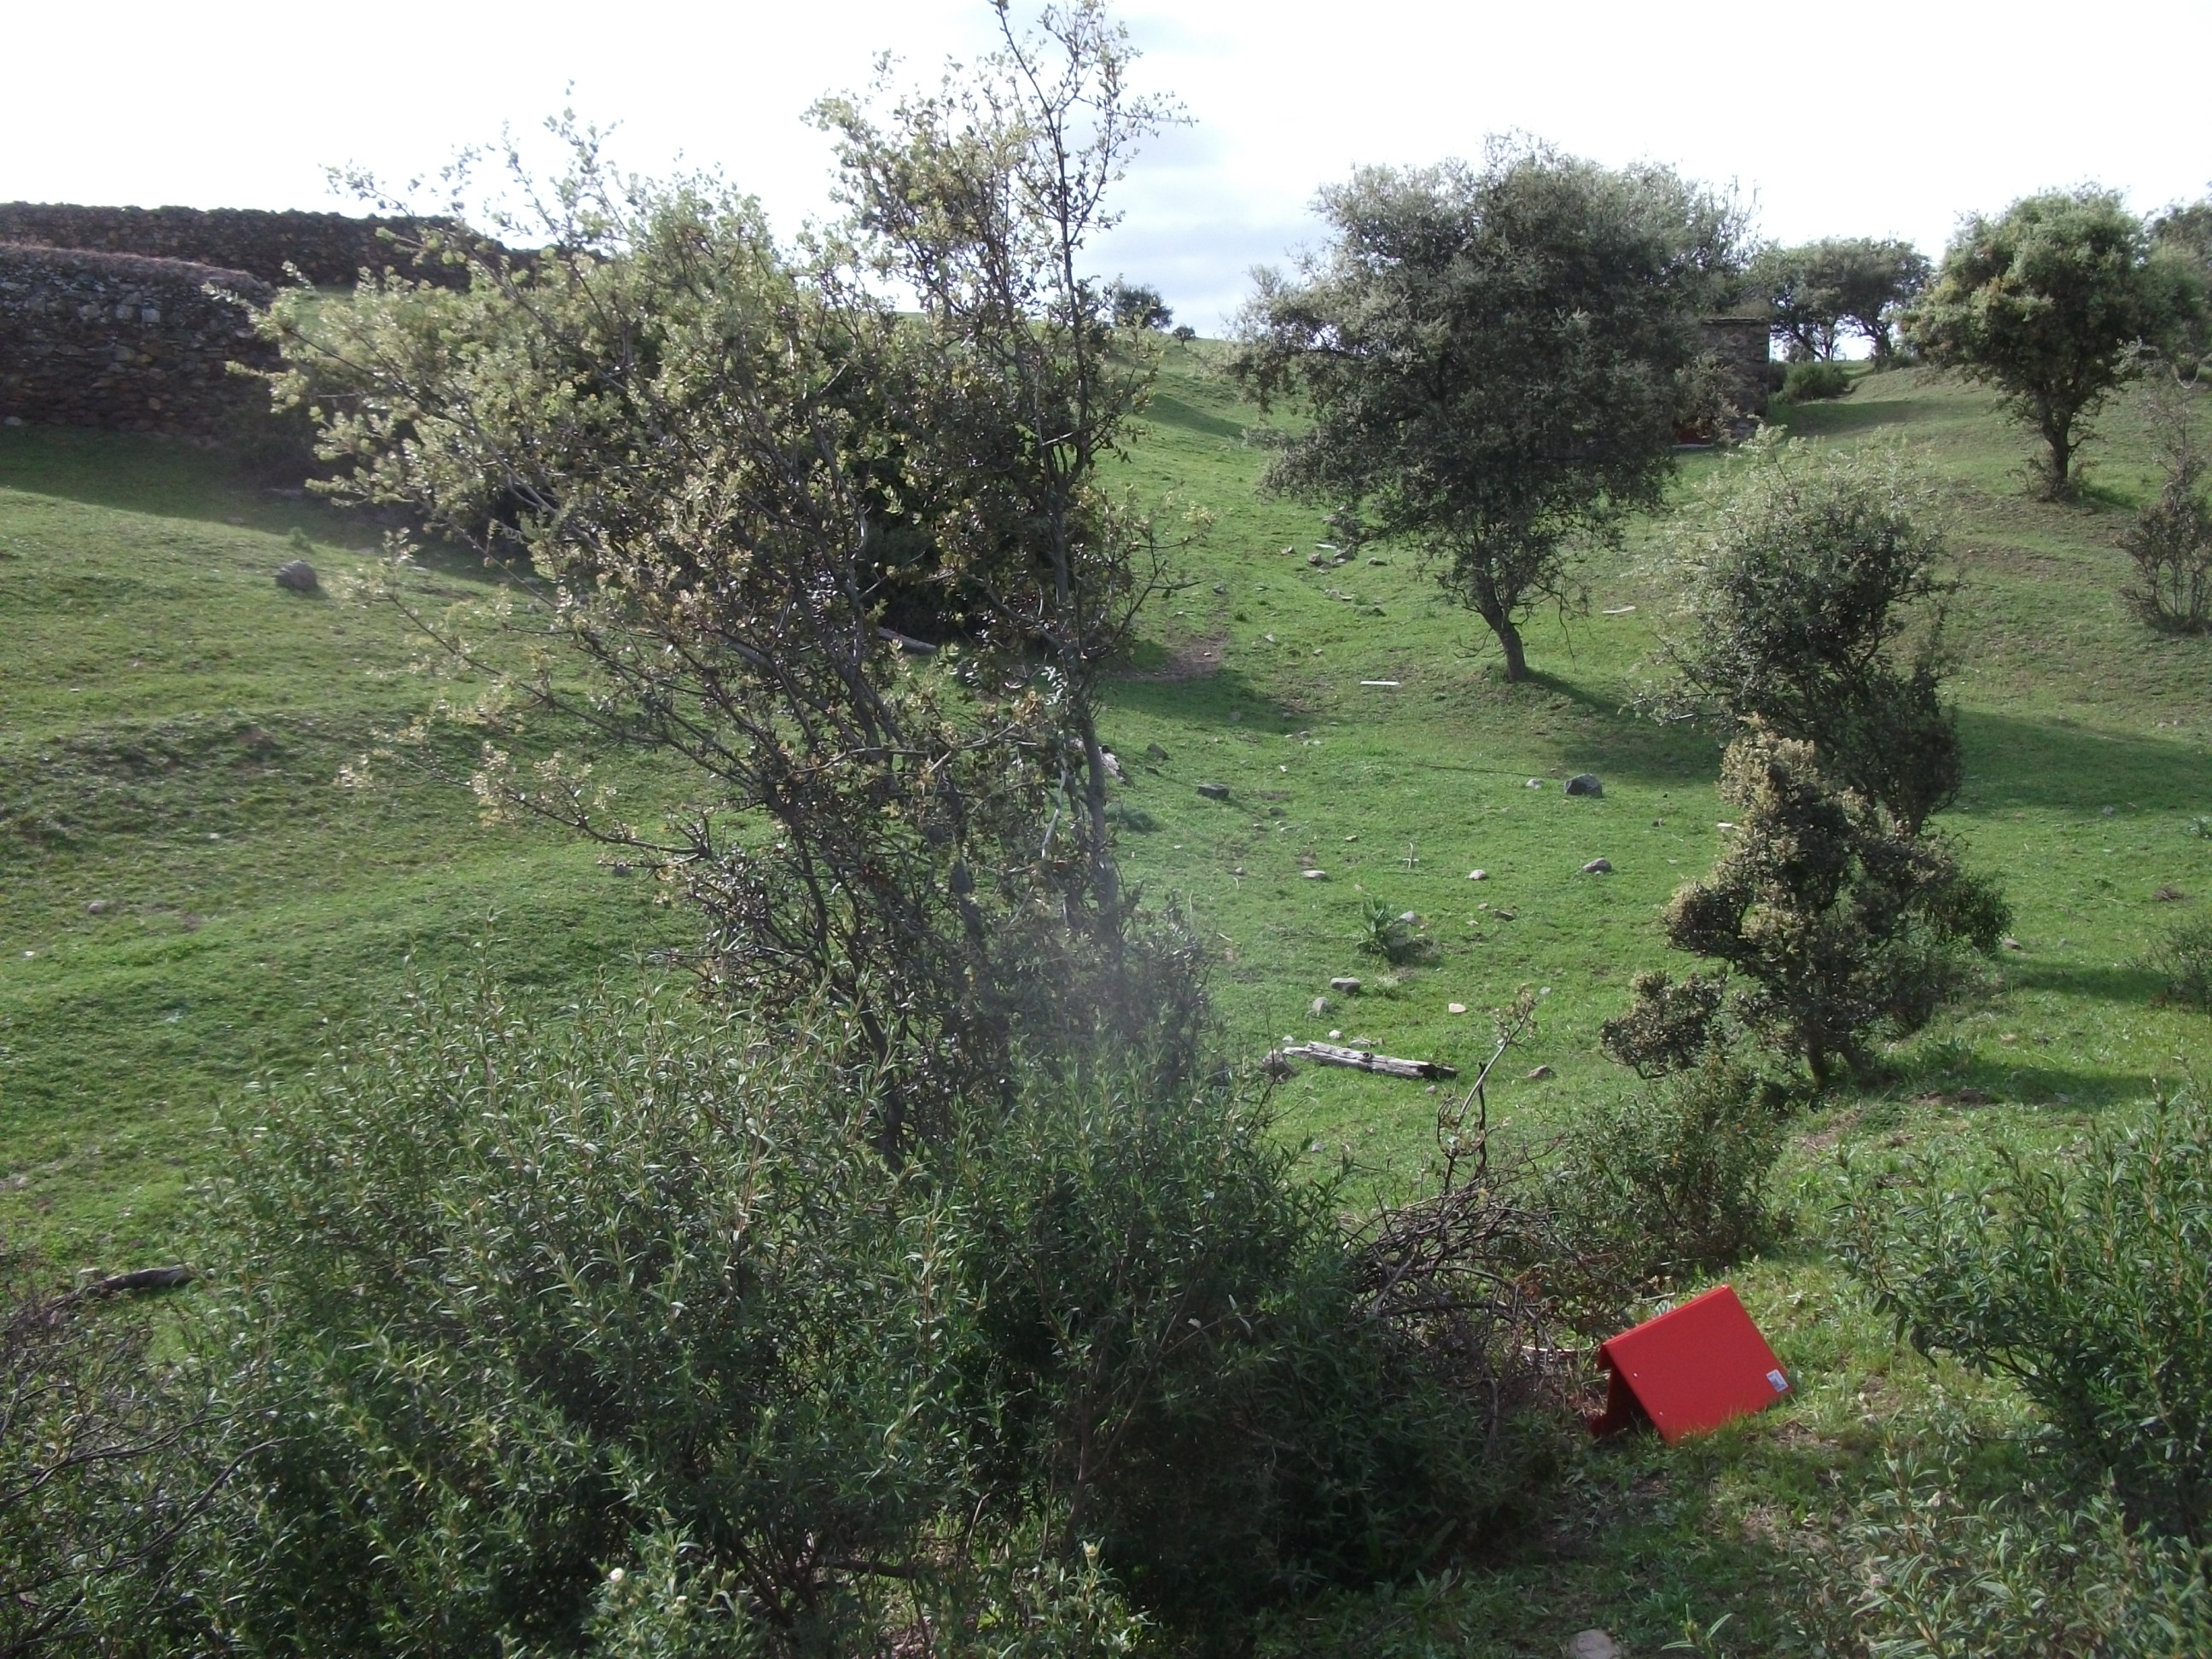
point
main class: Woodland
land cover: Broadleaved woodland
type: broadleaved evergreen forest
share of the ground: 25 - 50 %
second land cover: Shrubland without tree cover
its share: 25 - 50 %
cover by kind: shrubs 40 %, broadleaved forest trees 30 %, herbaceous plants 30 %
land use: Forestry
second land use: Agriculture (excluding fallow land and kitchen gardens)
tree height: < 5 m
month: April
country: ES
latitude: 37.8834
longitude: -6.4942
